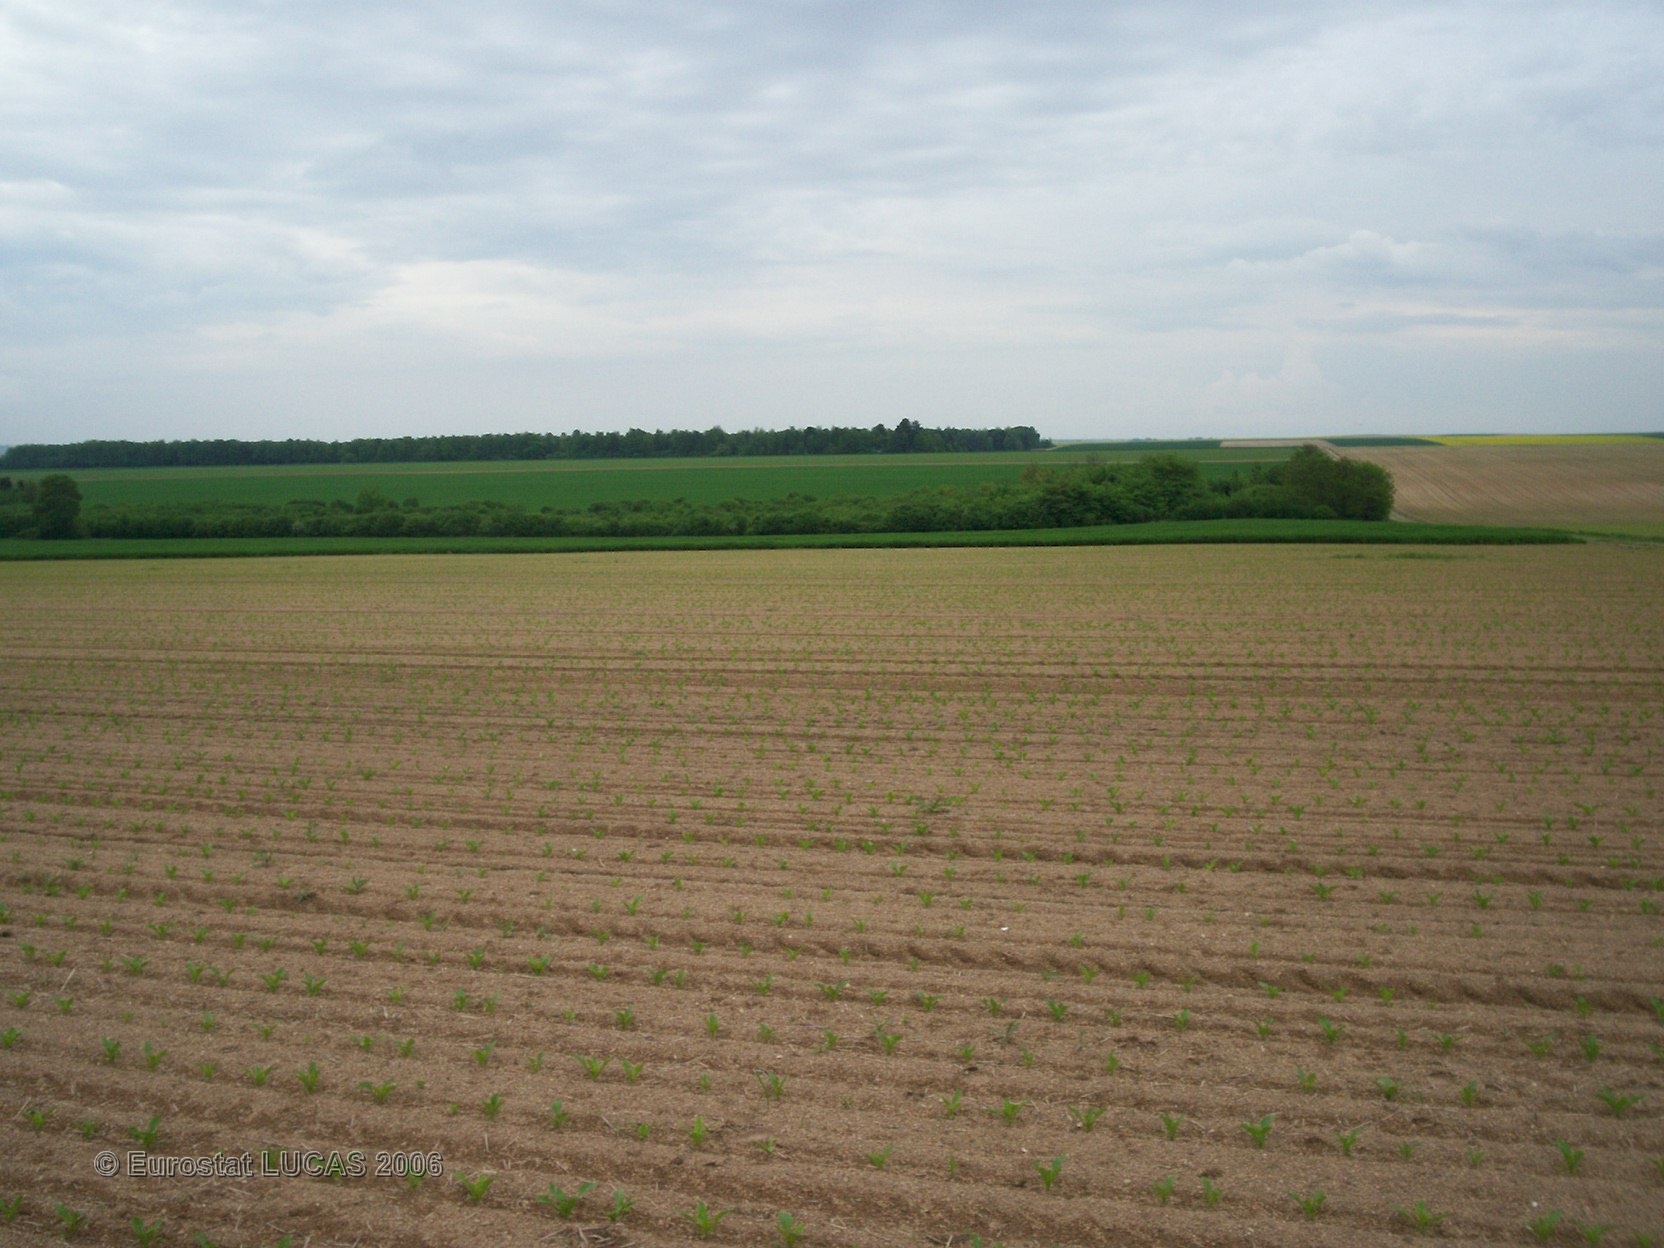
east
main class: Cropland
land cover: Sugar beet
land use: Agriculture (excluding fallow land and kitchen gardens)
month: May
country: FR
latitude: 49.2688
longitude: 4.3475
